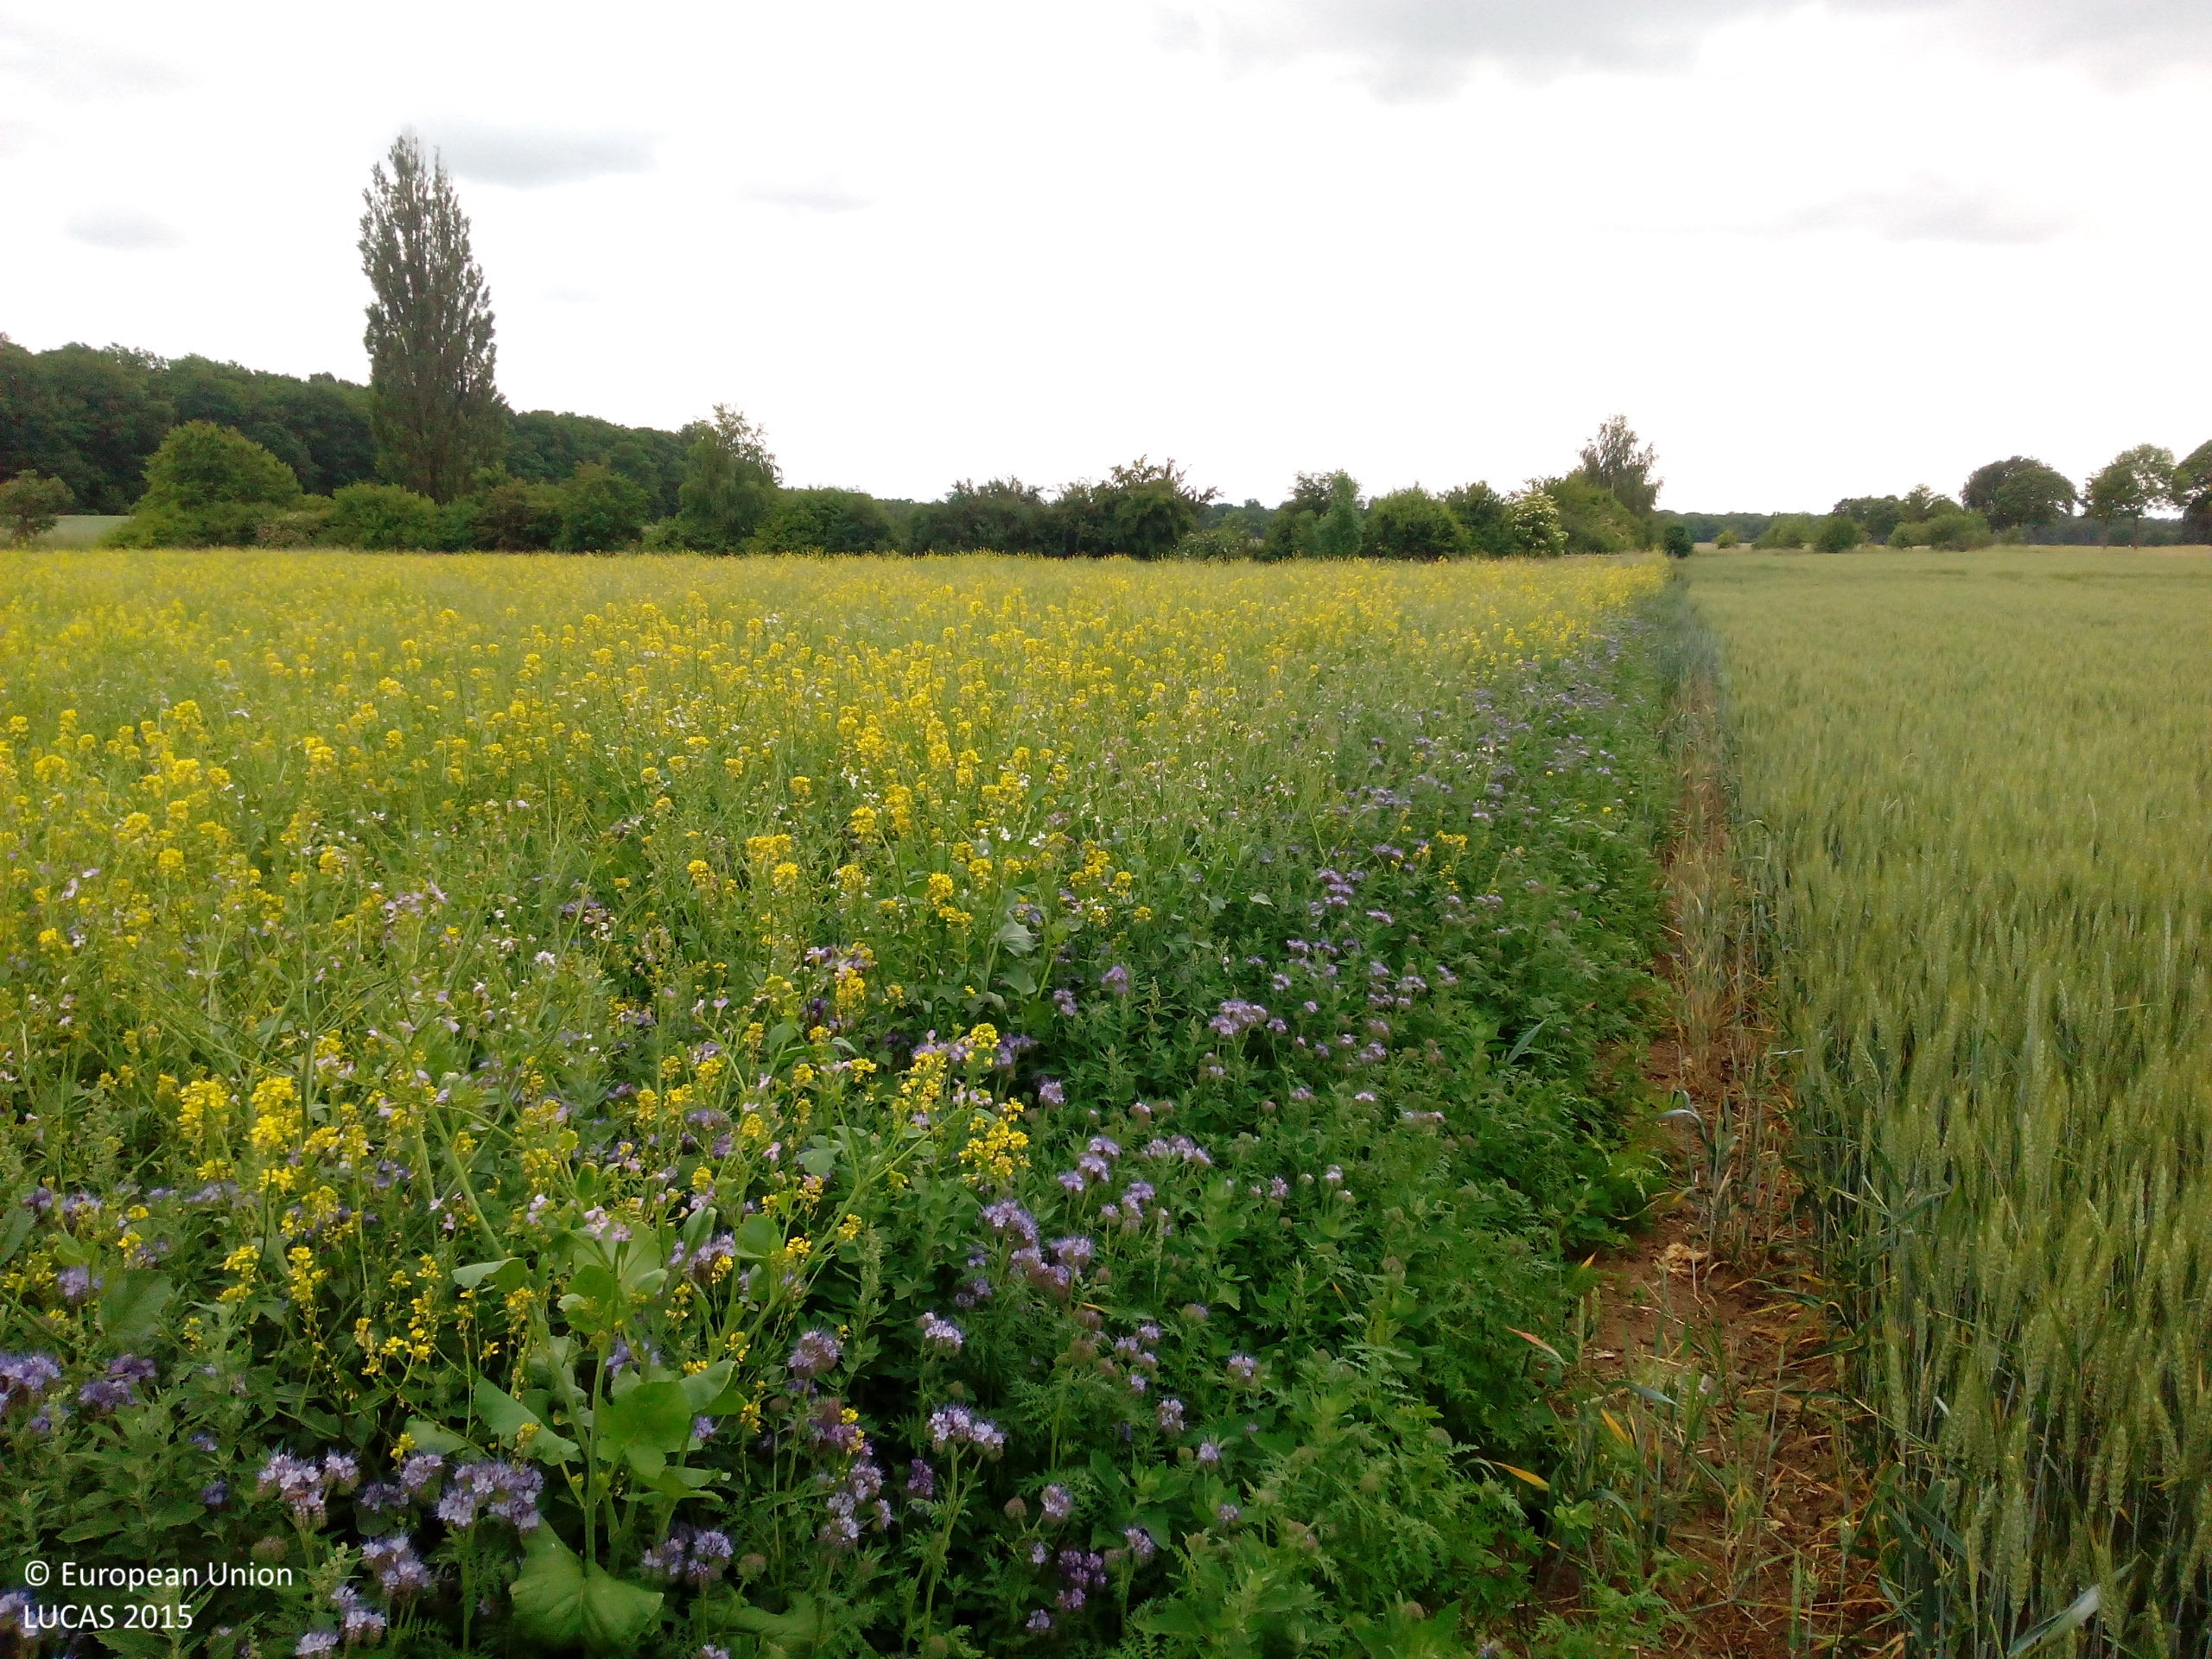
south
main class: Cropland
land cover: Other fibre and oleaginous crops
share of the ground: > 75 %
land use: Agriculture (excluding fallow land and kitchen gardens)
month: June
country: DE
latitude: 52.3578
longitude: 10.6312
